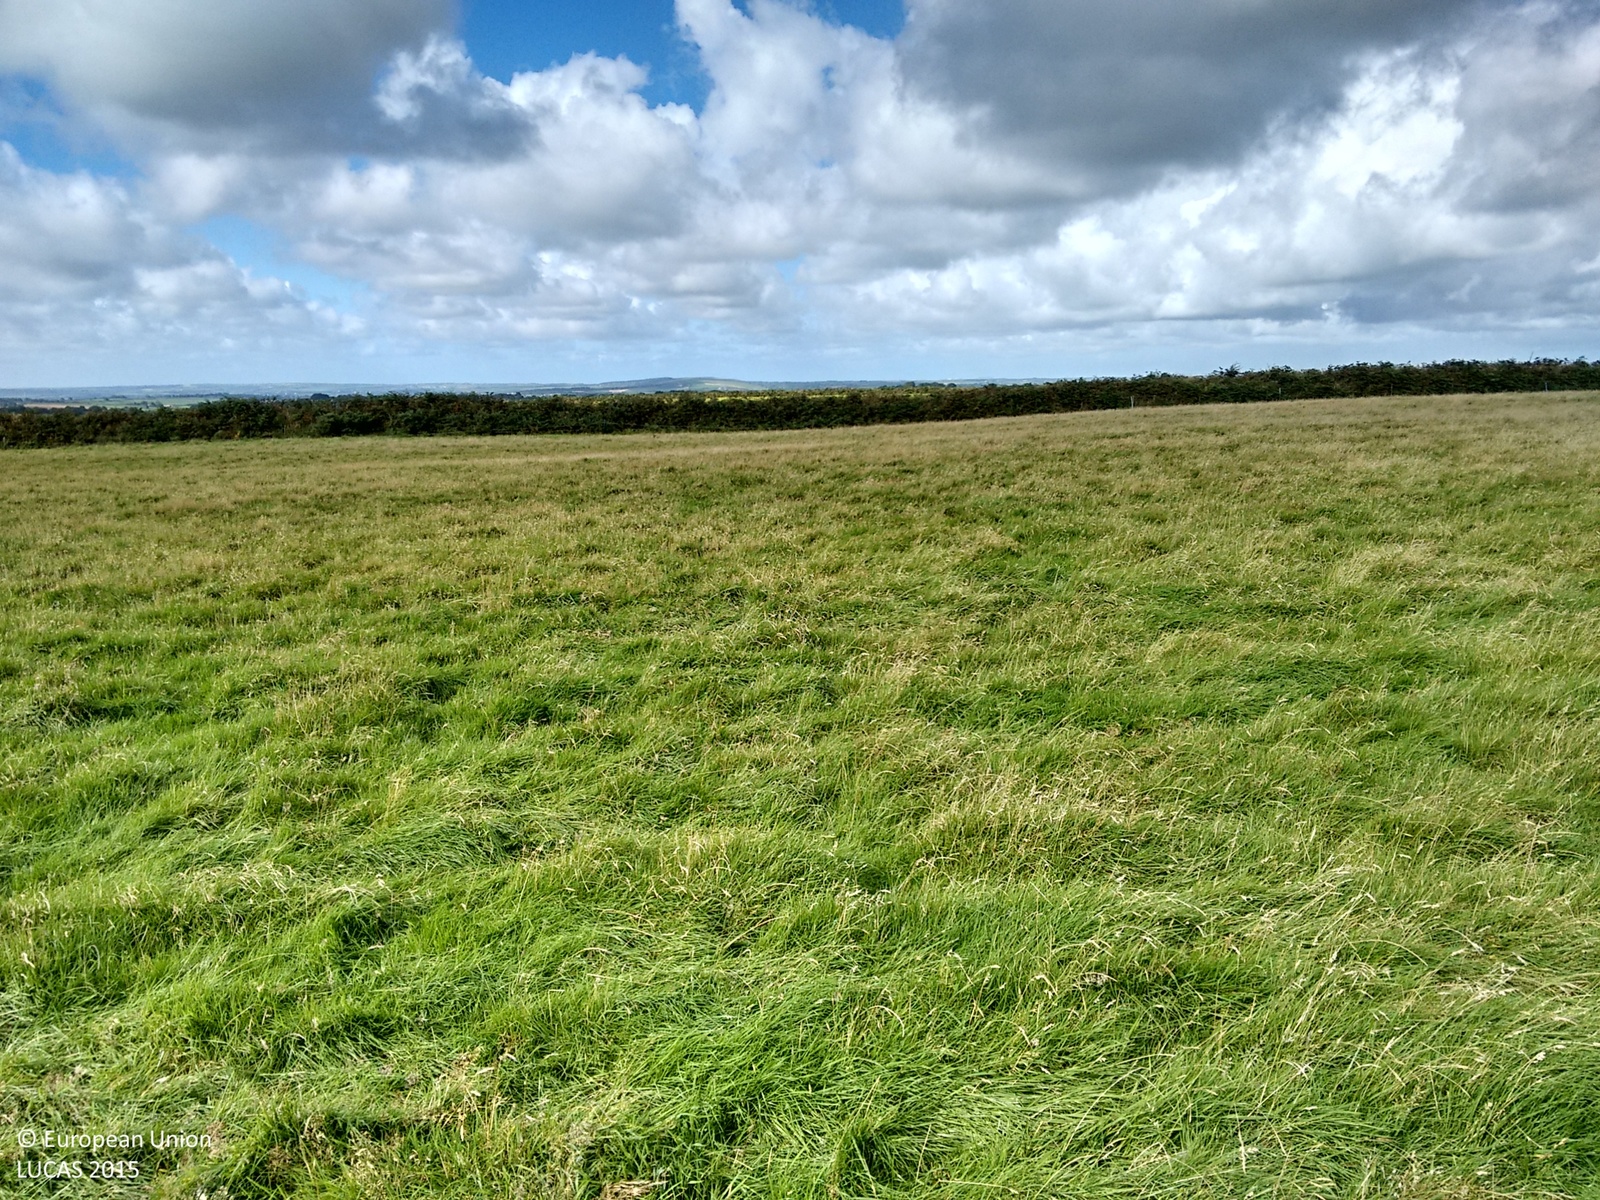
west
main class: Grassland
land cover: Grassland without tree/shrub cover
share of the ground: > 75 %
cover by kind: herbaceous plants 100 %
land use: Agriculture (excluding fallow land and kitchen gardens)
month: August
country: GB
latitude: 51.9095
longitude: -4.8685
